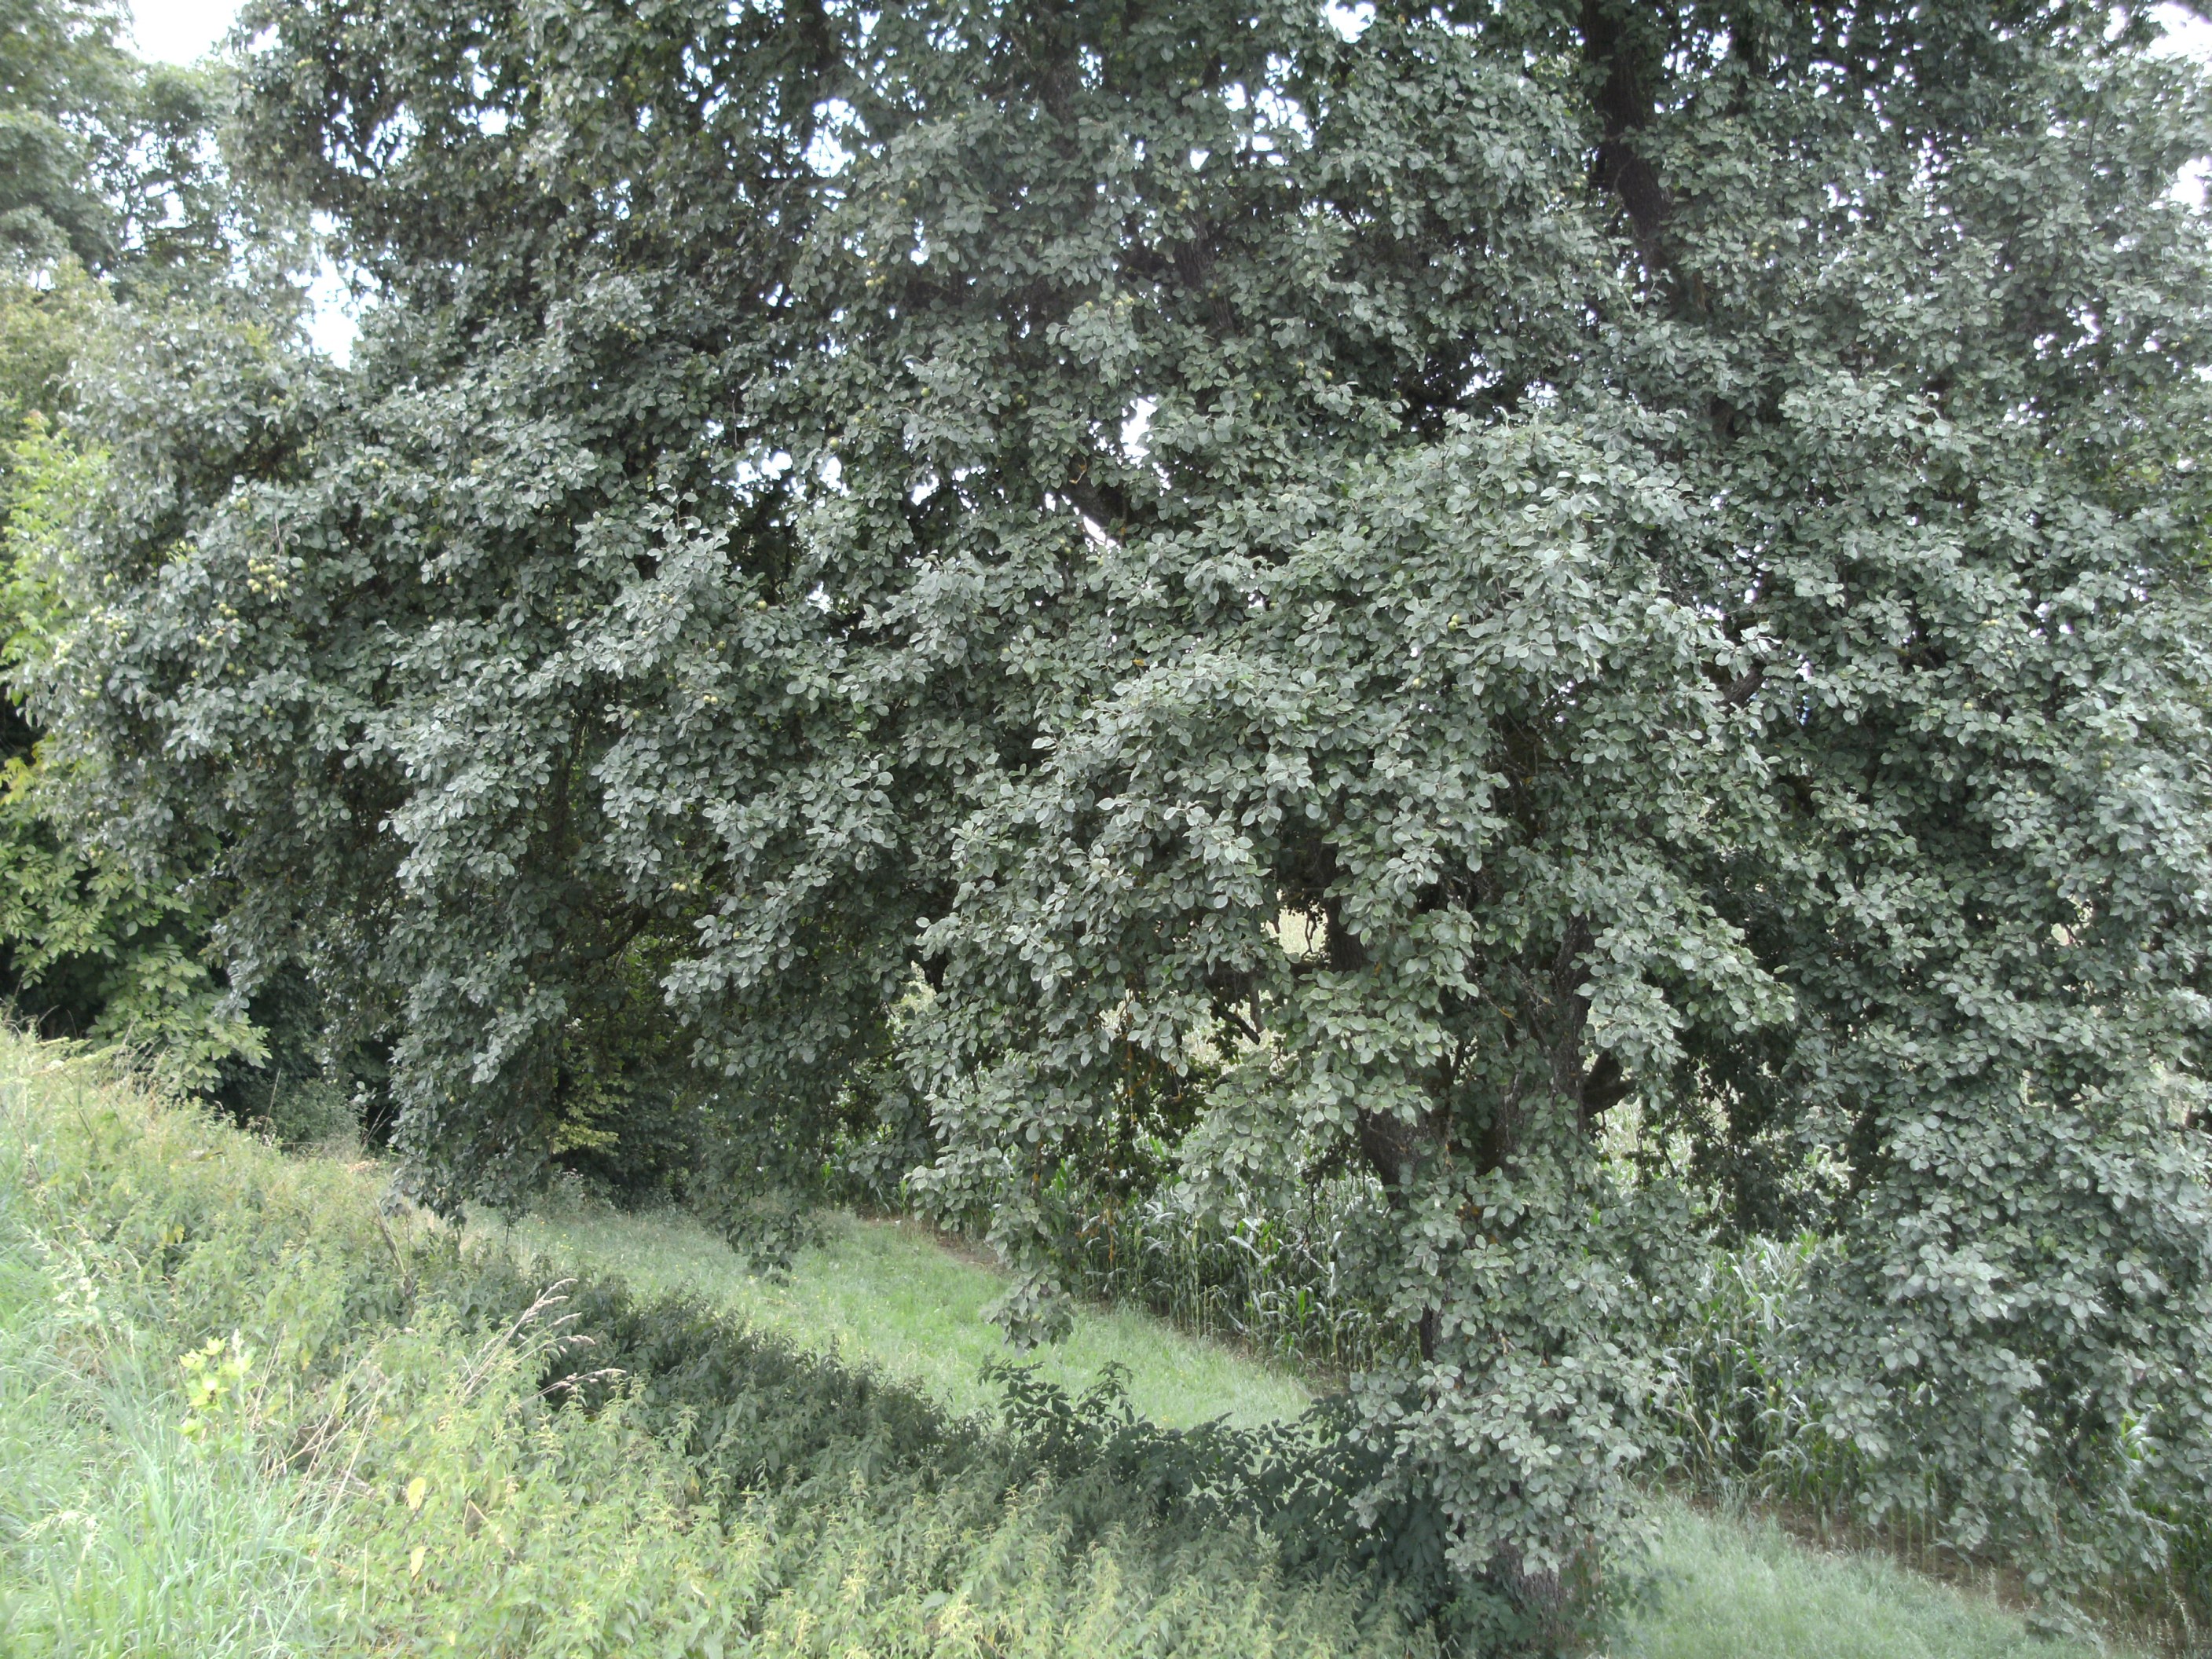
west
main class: Cropland
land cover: Maize
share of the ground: > 75 %
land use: Agriculture (excluding fallow land and kitchen gardens)
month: July
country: AT
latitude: 46.6319
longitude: 14.5824
